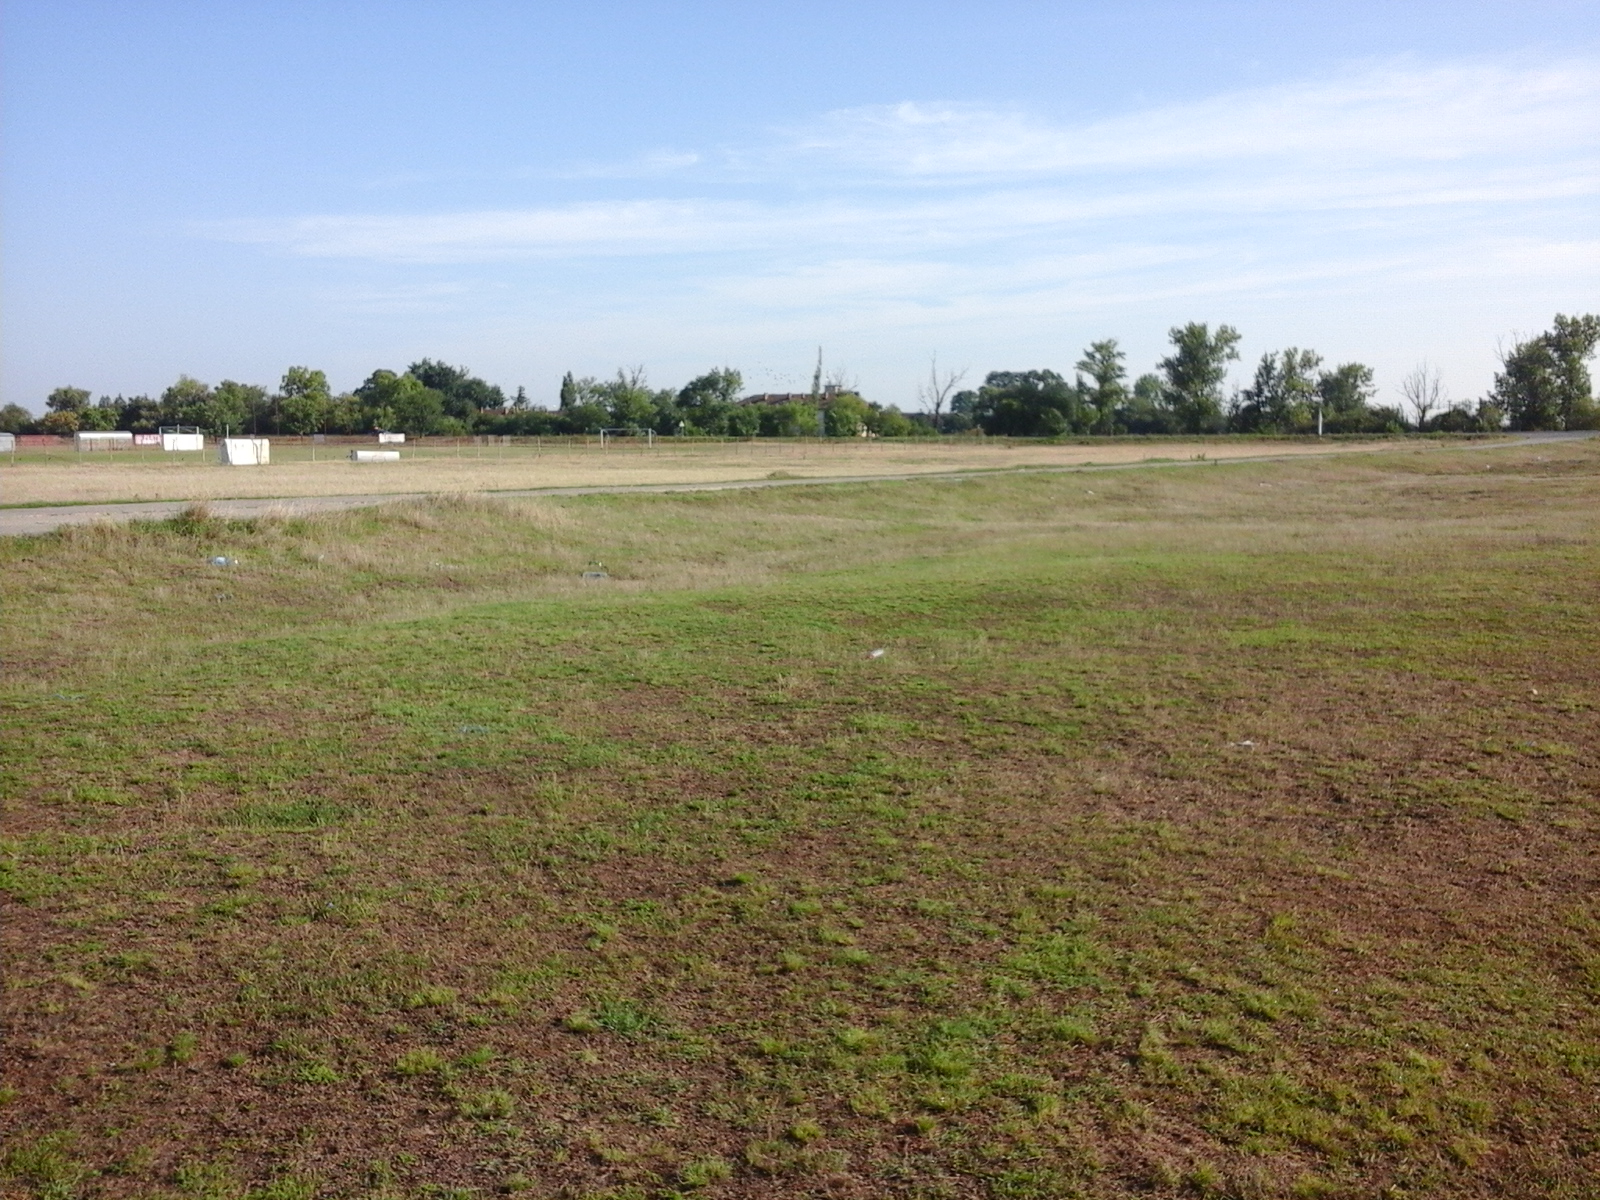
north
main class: Grassland
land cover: Grassland without tree/shrub cover
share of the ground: > 75 %
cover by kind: herbaceous plants 100 %
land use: Agriculture (excluding fallow land and kitchen gardens)
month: August
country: RO
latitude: 45.8328
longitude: 21.0359
